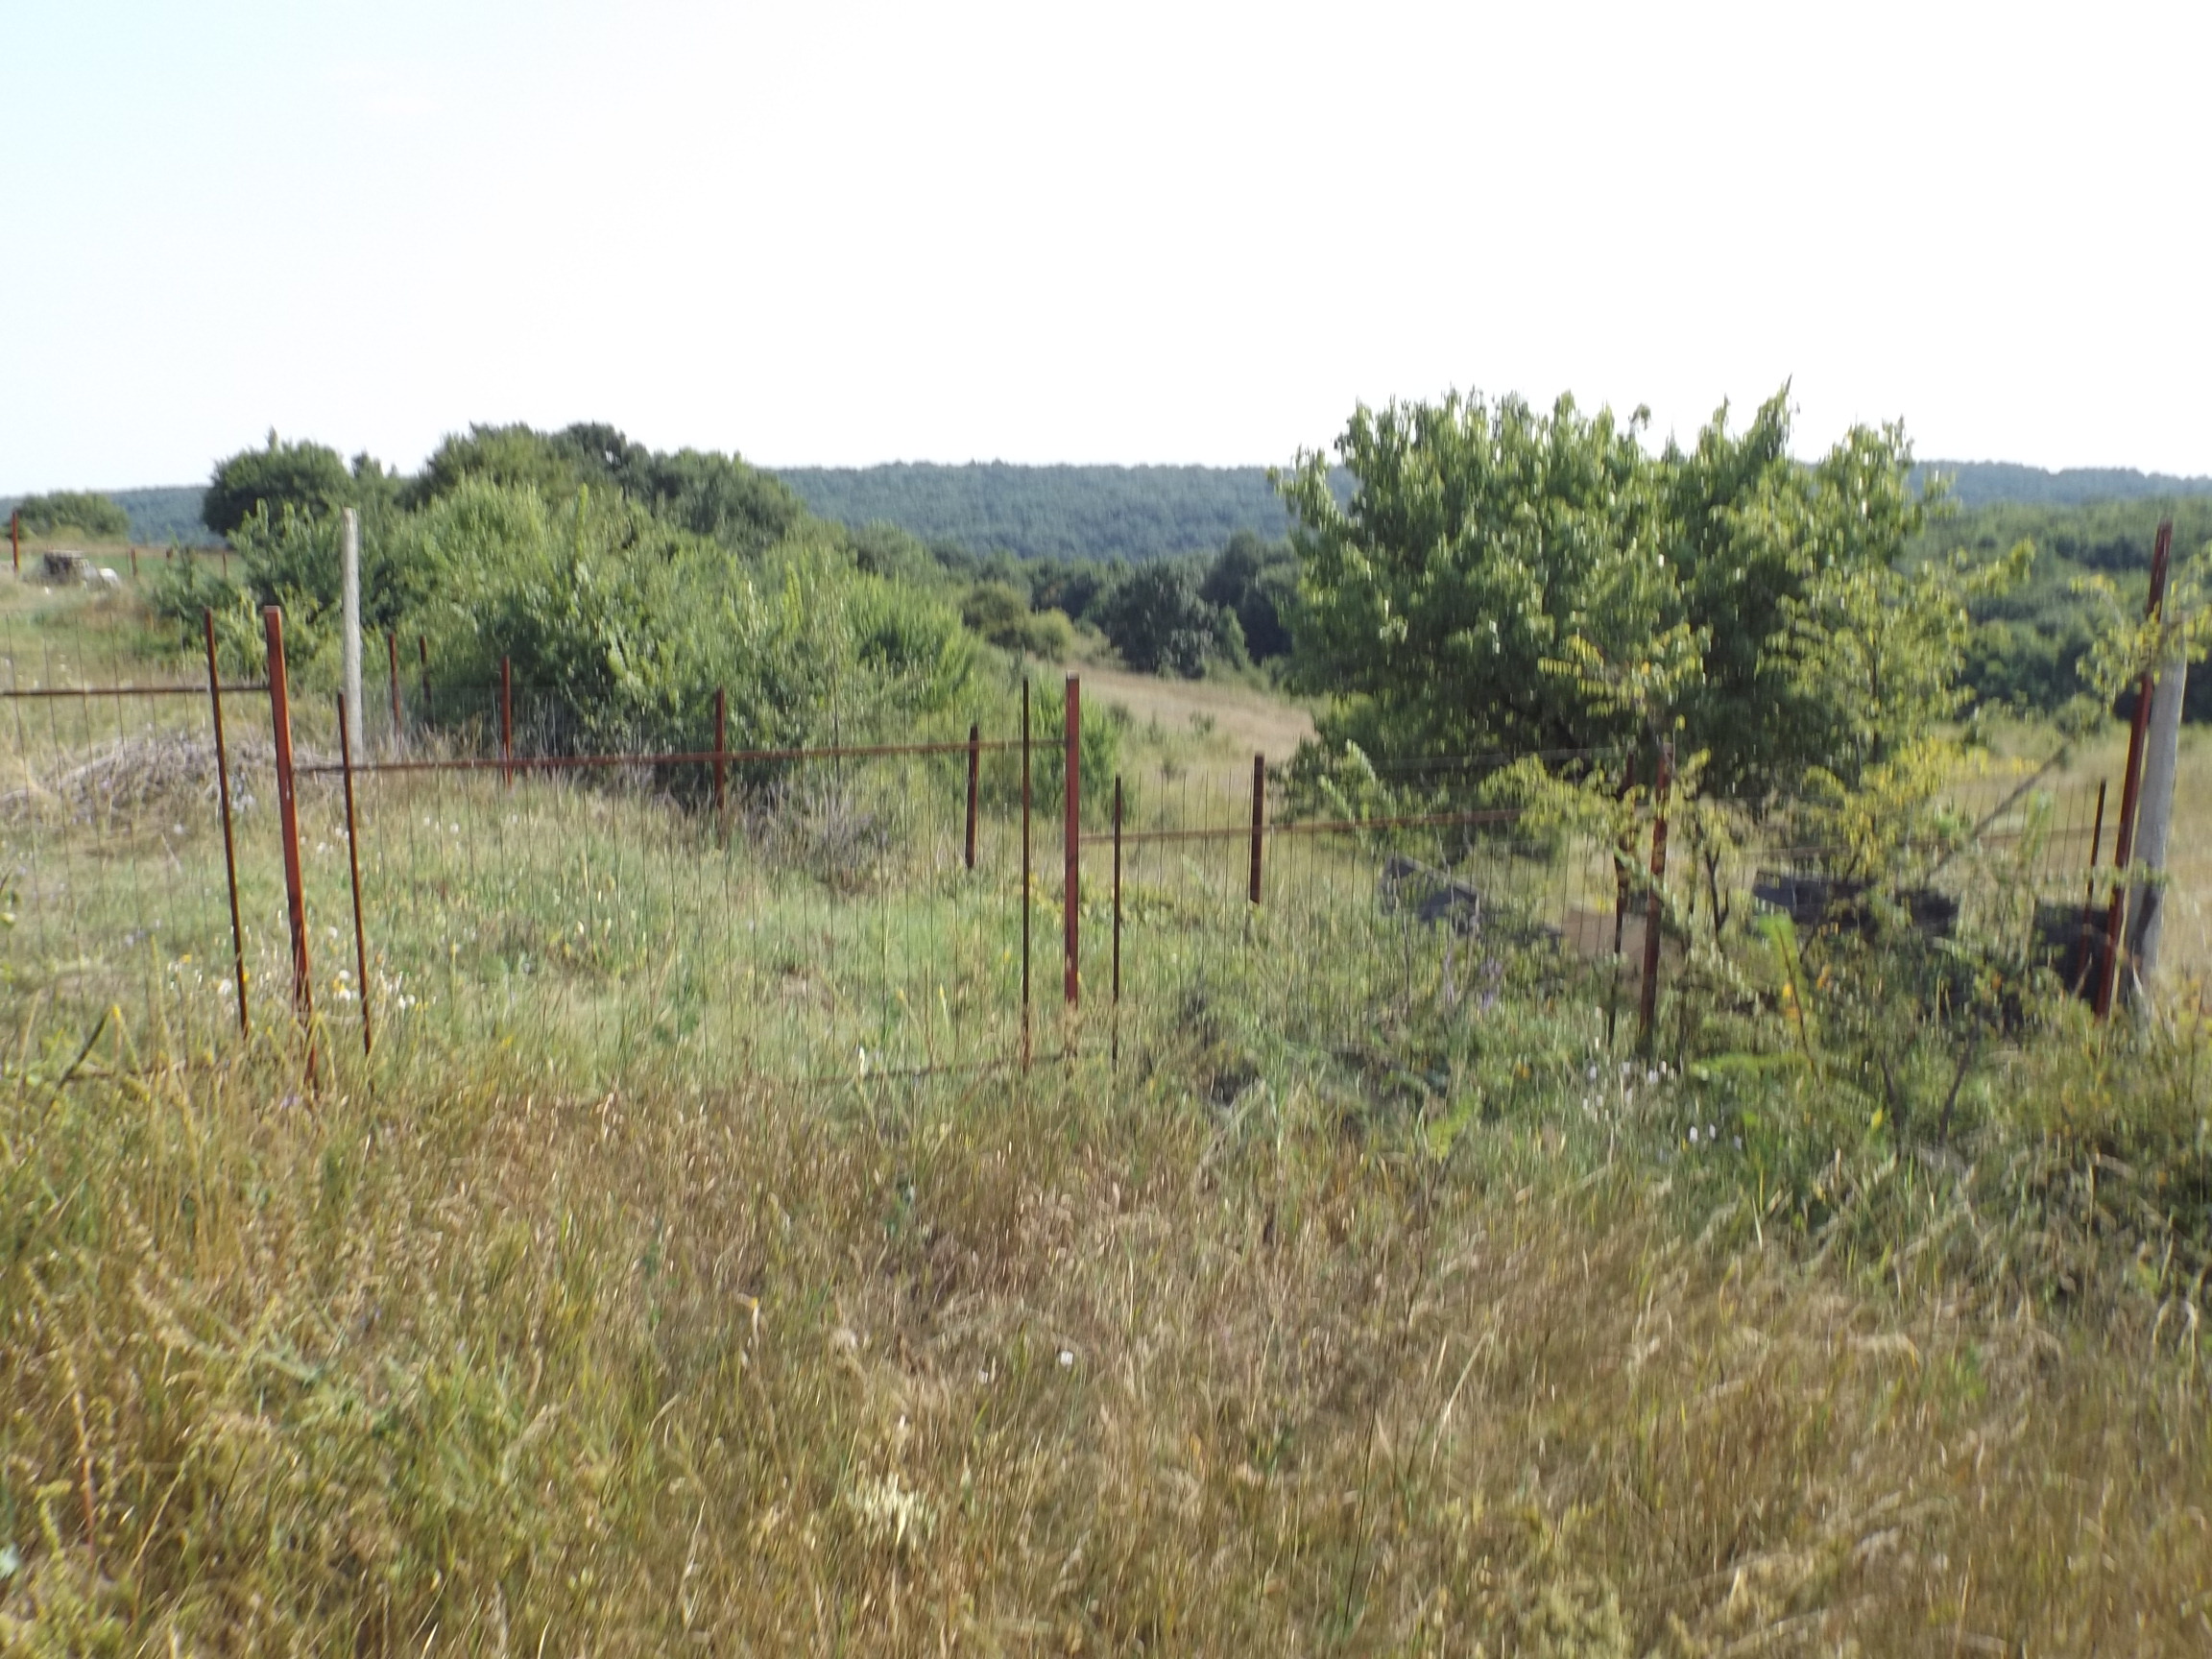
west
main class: Grassland
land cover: Spontaneously vegetated surfaces
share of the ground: > 75 %
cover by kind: herbaceous plants 100 %
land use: Fallow land
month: July
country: BG
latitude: 43.2989
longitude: 27.8773
